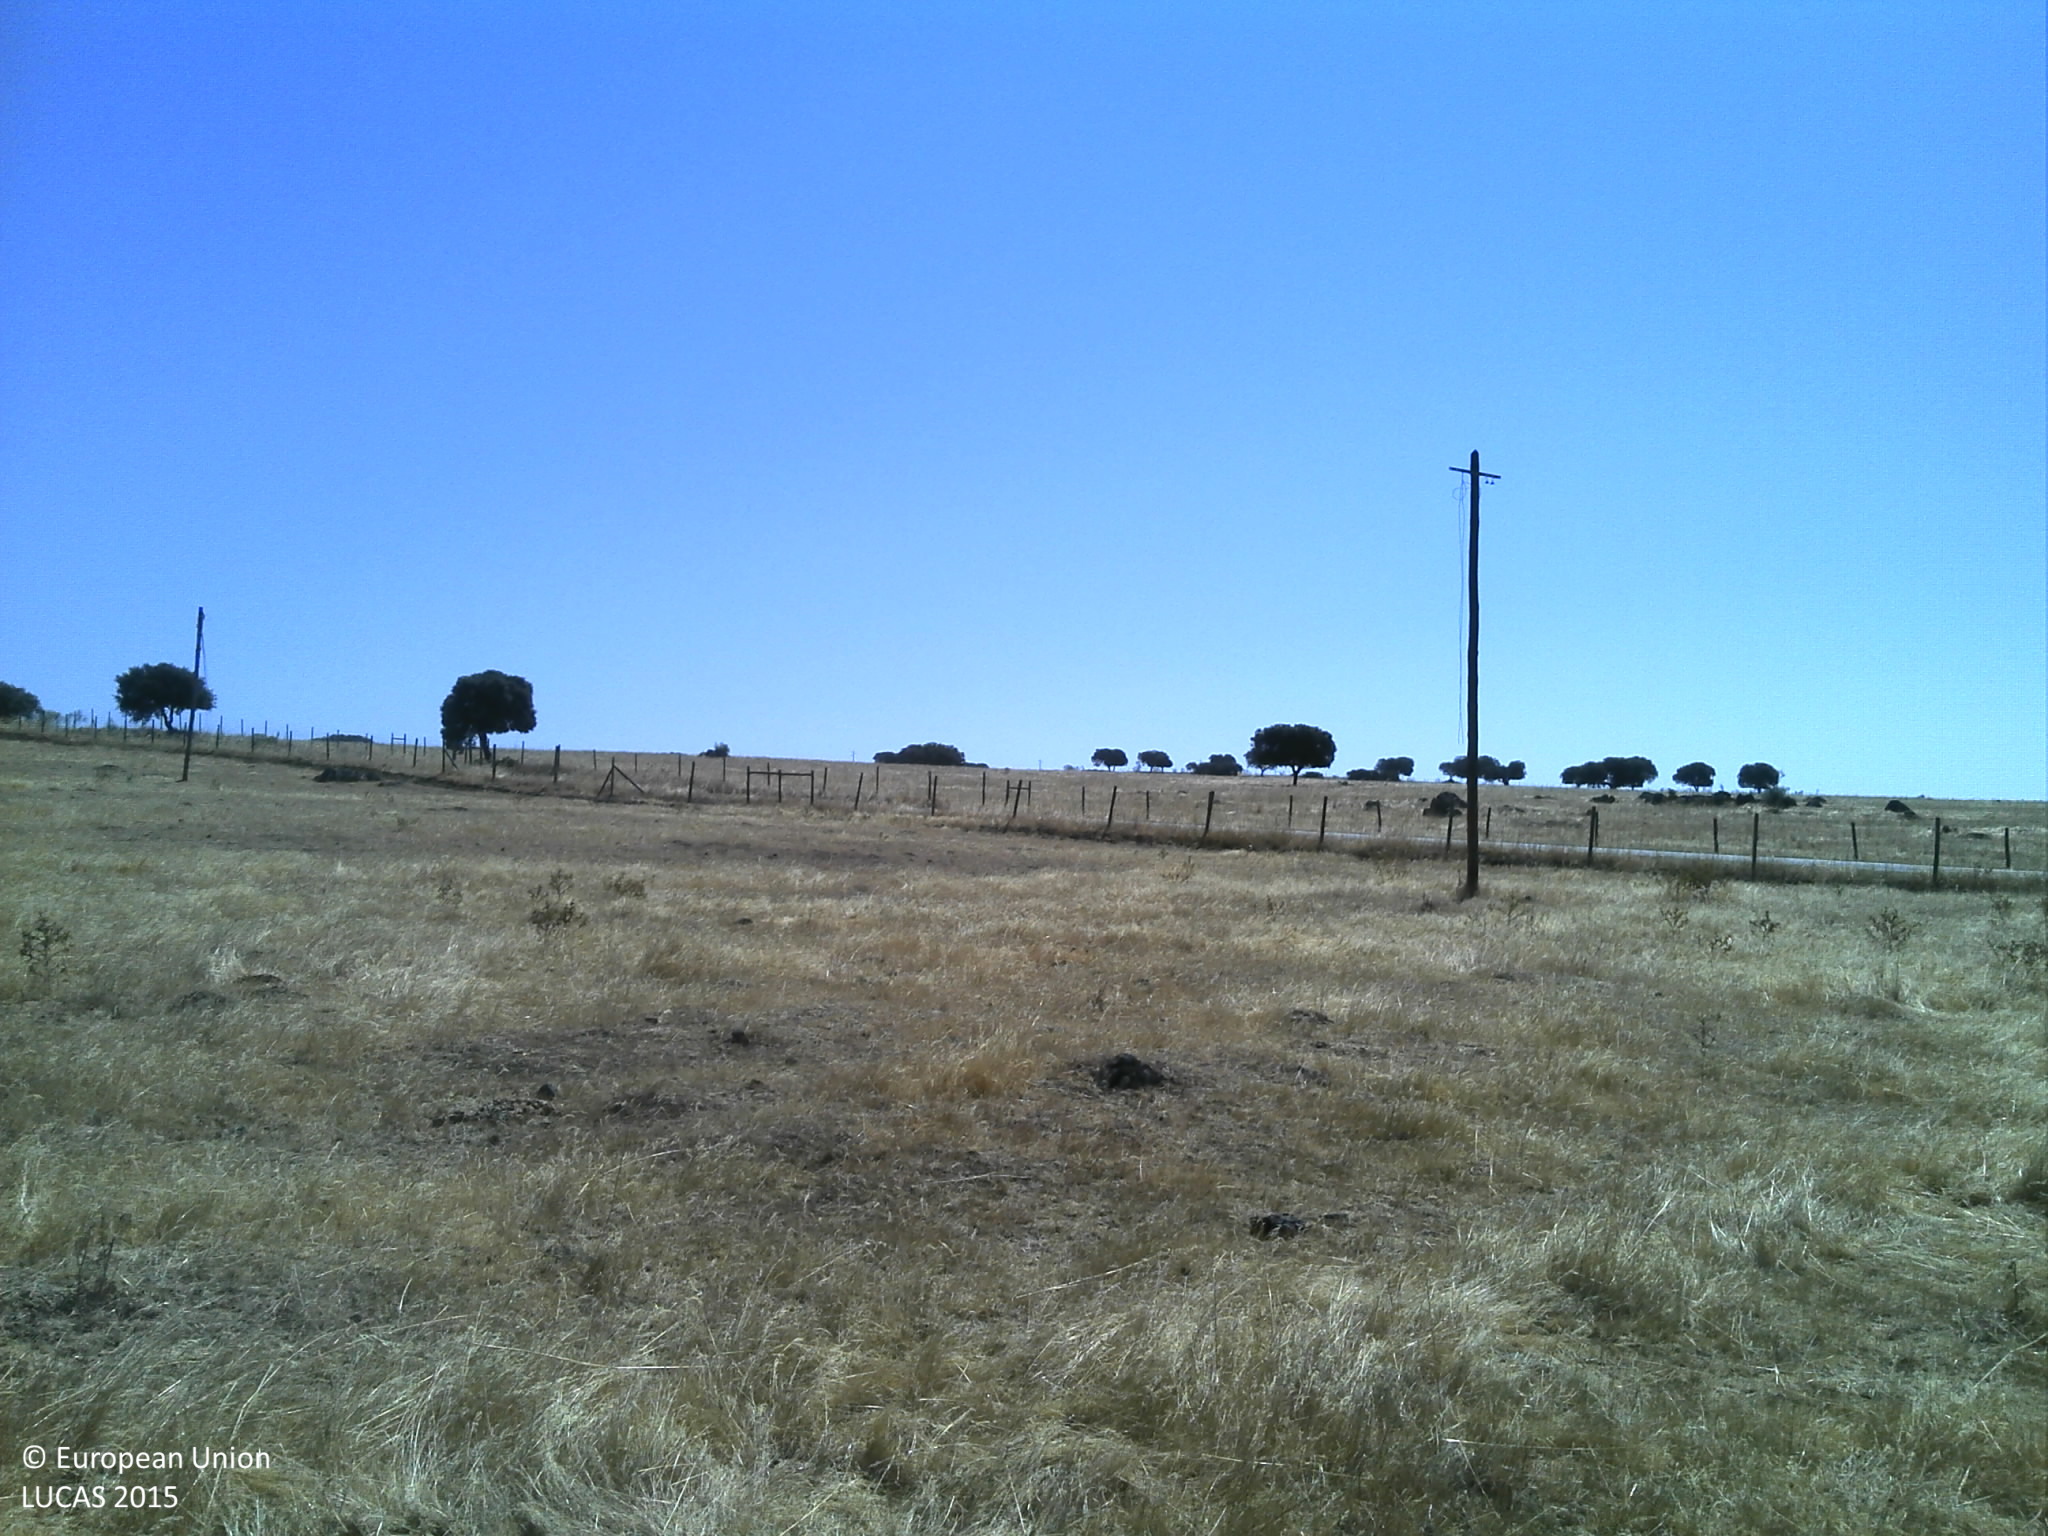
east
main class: Grassland
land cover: Grassland without tree/shrub cover
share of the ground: 50 - 75 %
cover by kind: herbaceous plants 60 %, unconsolidated bare surface 40 %
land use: Agriculture (excluding fallow land and kitchen gardens)
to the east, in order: Grassland without tree/shrub cover; Electric lines; Grassland without tree/shrub cover; Other bare soil; Fences; Grass margins; Paved roads, cycling and walking lanes; Grass margins; Fences; Other bare soil; Grassland without tree/shrub cover; Single bushes/trees; Grassland without tree/shrub cover
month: July
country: PT
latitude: 39.1195
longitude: -7.4221
